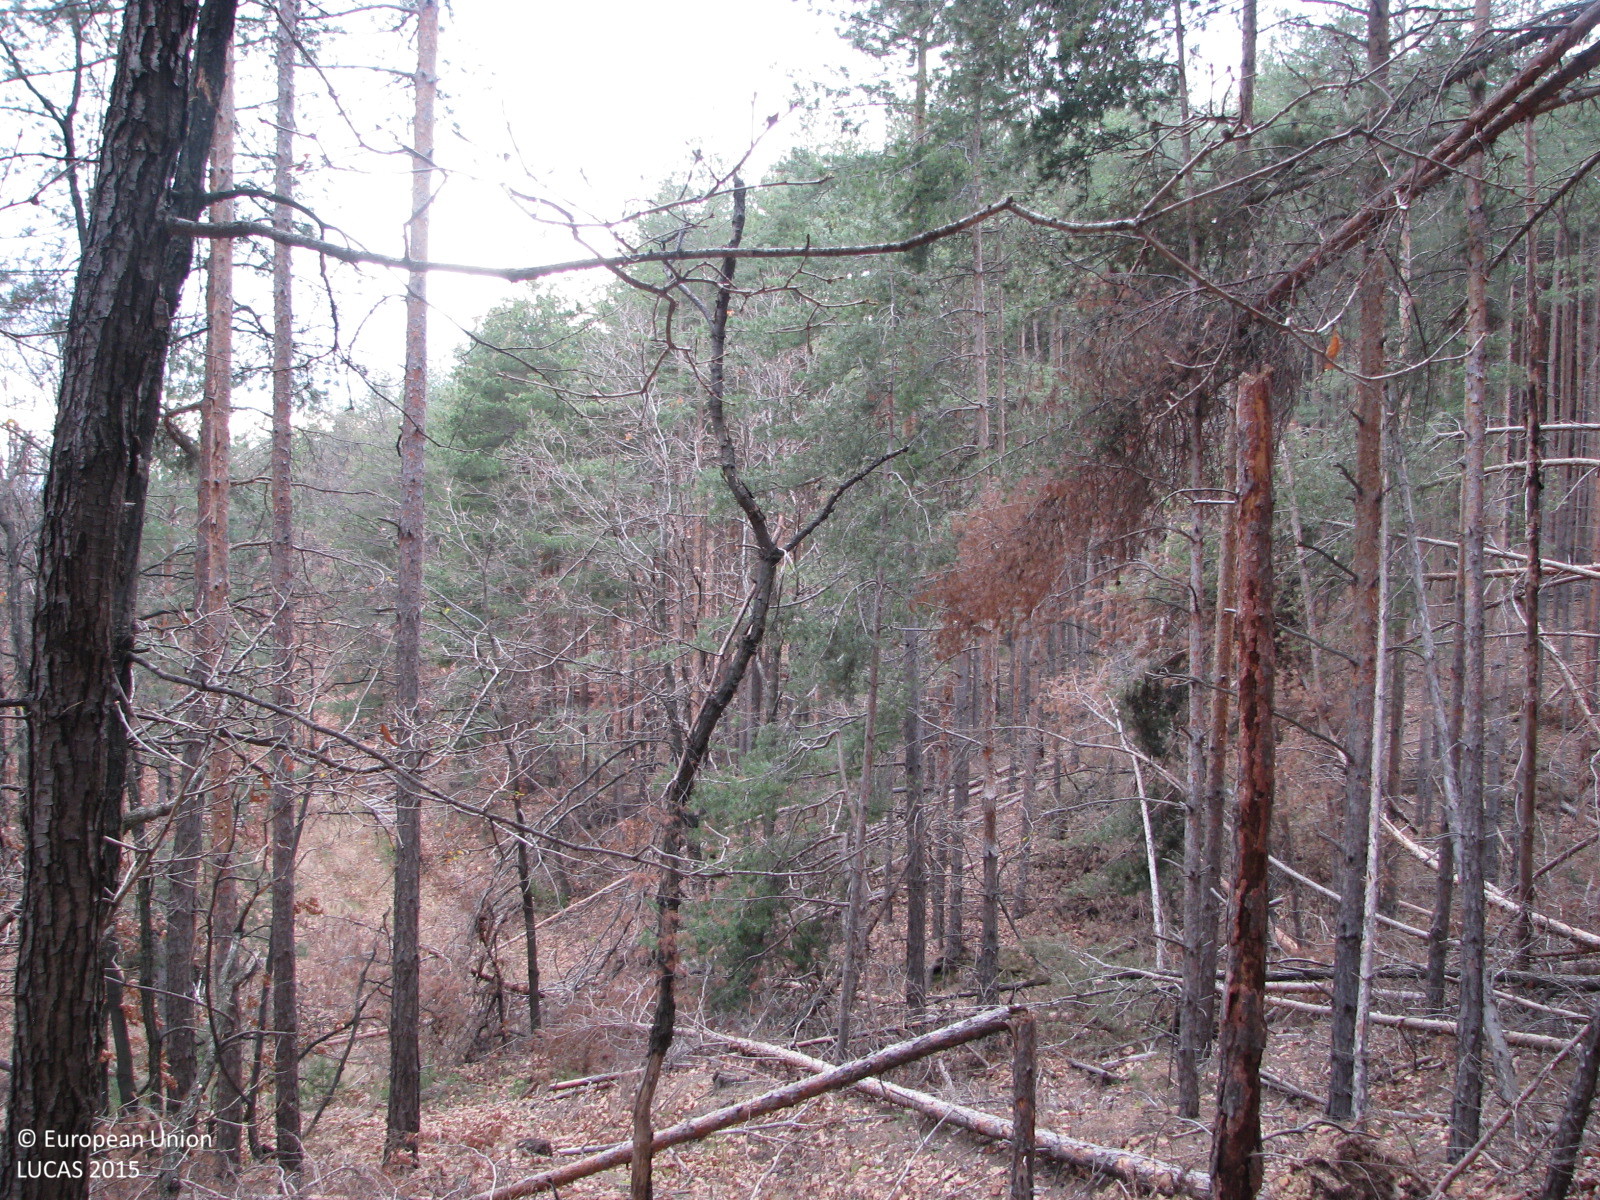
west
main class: Woodland
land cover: Pine dominated mixed woodland
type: hemiboreal forest and nemoral coniferous forest and mixed broadleaved-coniferous forest
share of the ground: > 75 %
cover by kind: coniferous forest trees 60 %, broadleaved forest trees 30 %, unconsolidated bare surface 10 %
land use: Forestry
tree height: > 5 m
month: December
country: BG
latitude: 42.5184
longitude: 24.1280
